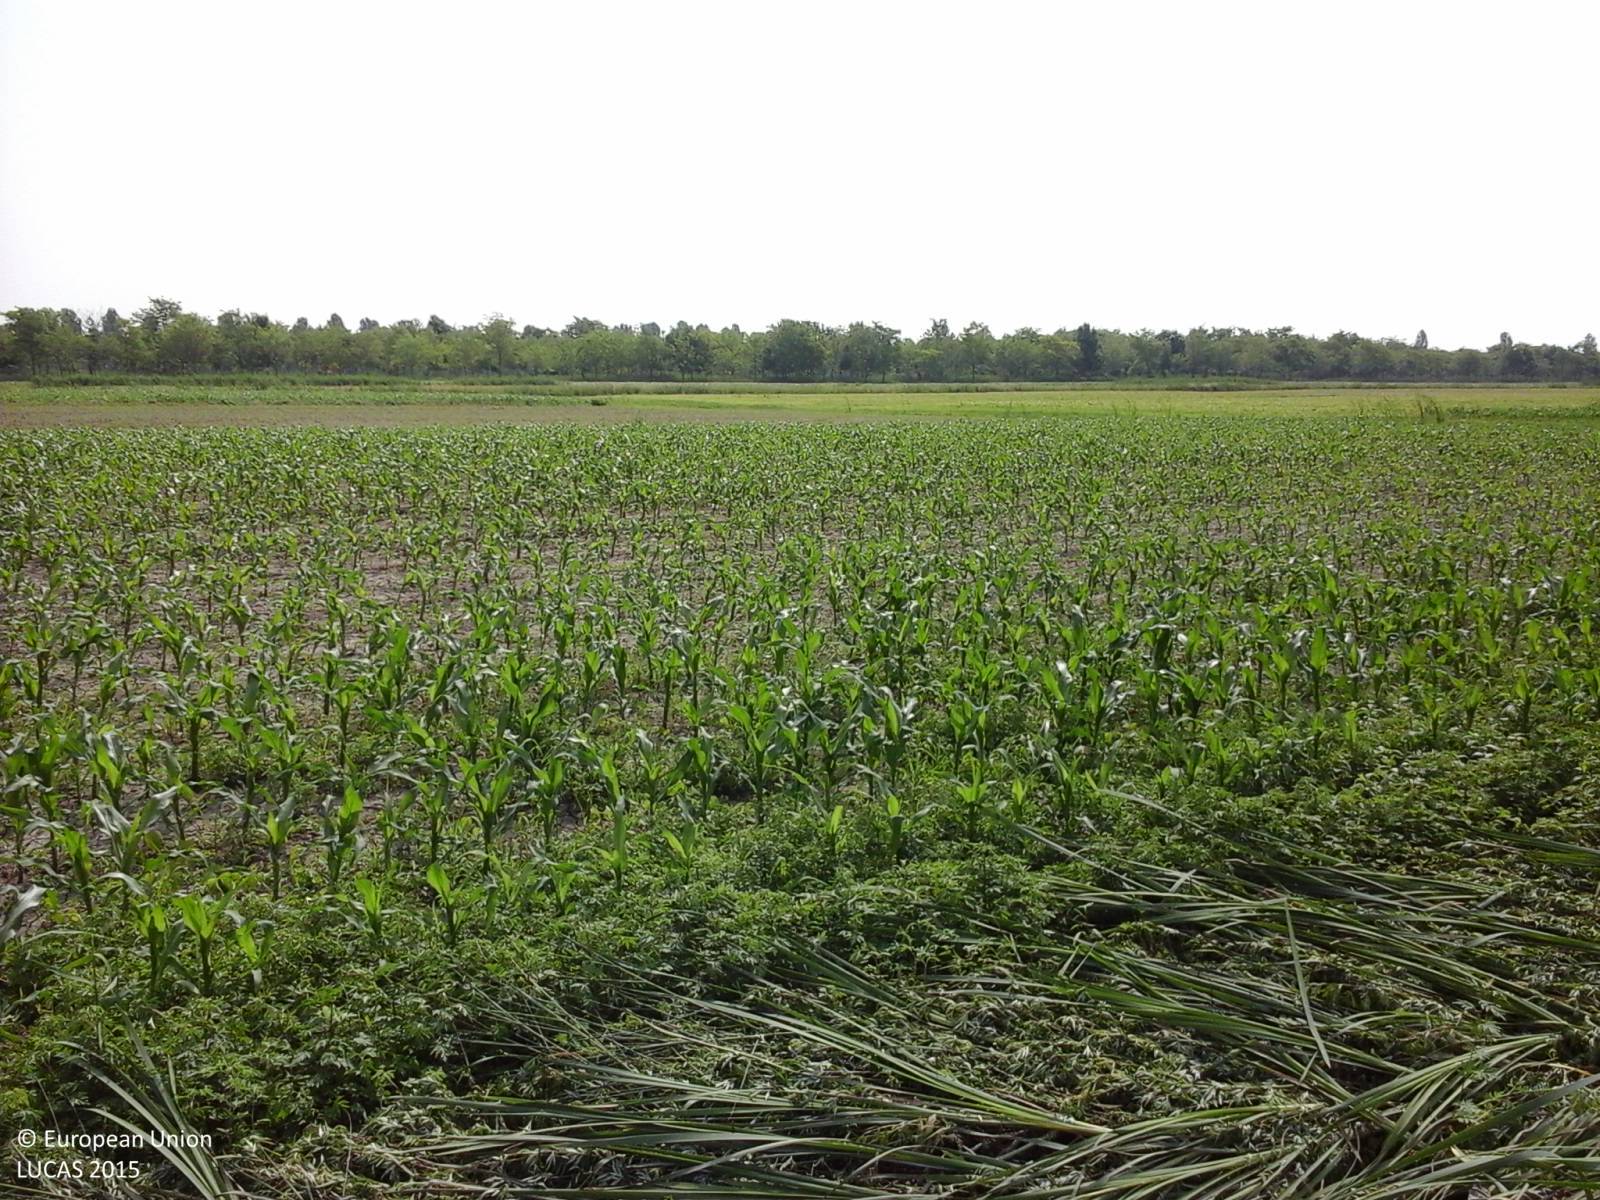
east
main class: Cropland
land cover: Soya
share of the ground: < 10 %
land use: Agriculture (excluding fallow land and kitchen gardens)
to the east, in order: Soya; Ditches and canals; Maize; Ditches and canals; Soya; Ditches and canals; Maize; Grass margins; Ditches and canals; Maize; Ditches and canals; Grass margins; Tracks; Maize; Ditches and canals; Broadleaved woodland; Maize; Ditches and canals; Broadleaved woodland; Maize; Broadleaved woodland; Maize
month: May
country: IT
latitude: 45.7594
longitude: 13.3001
